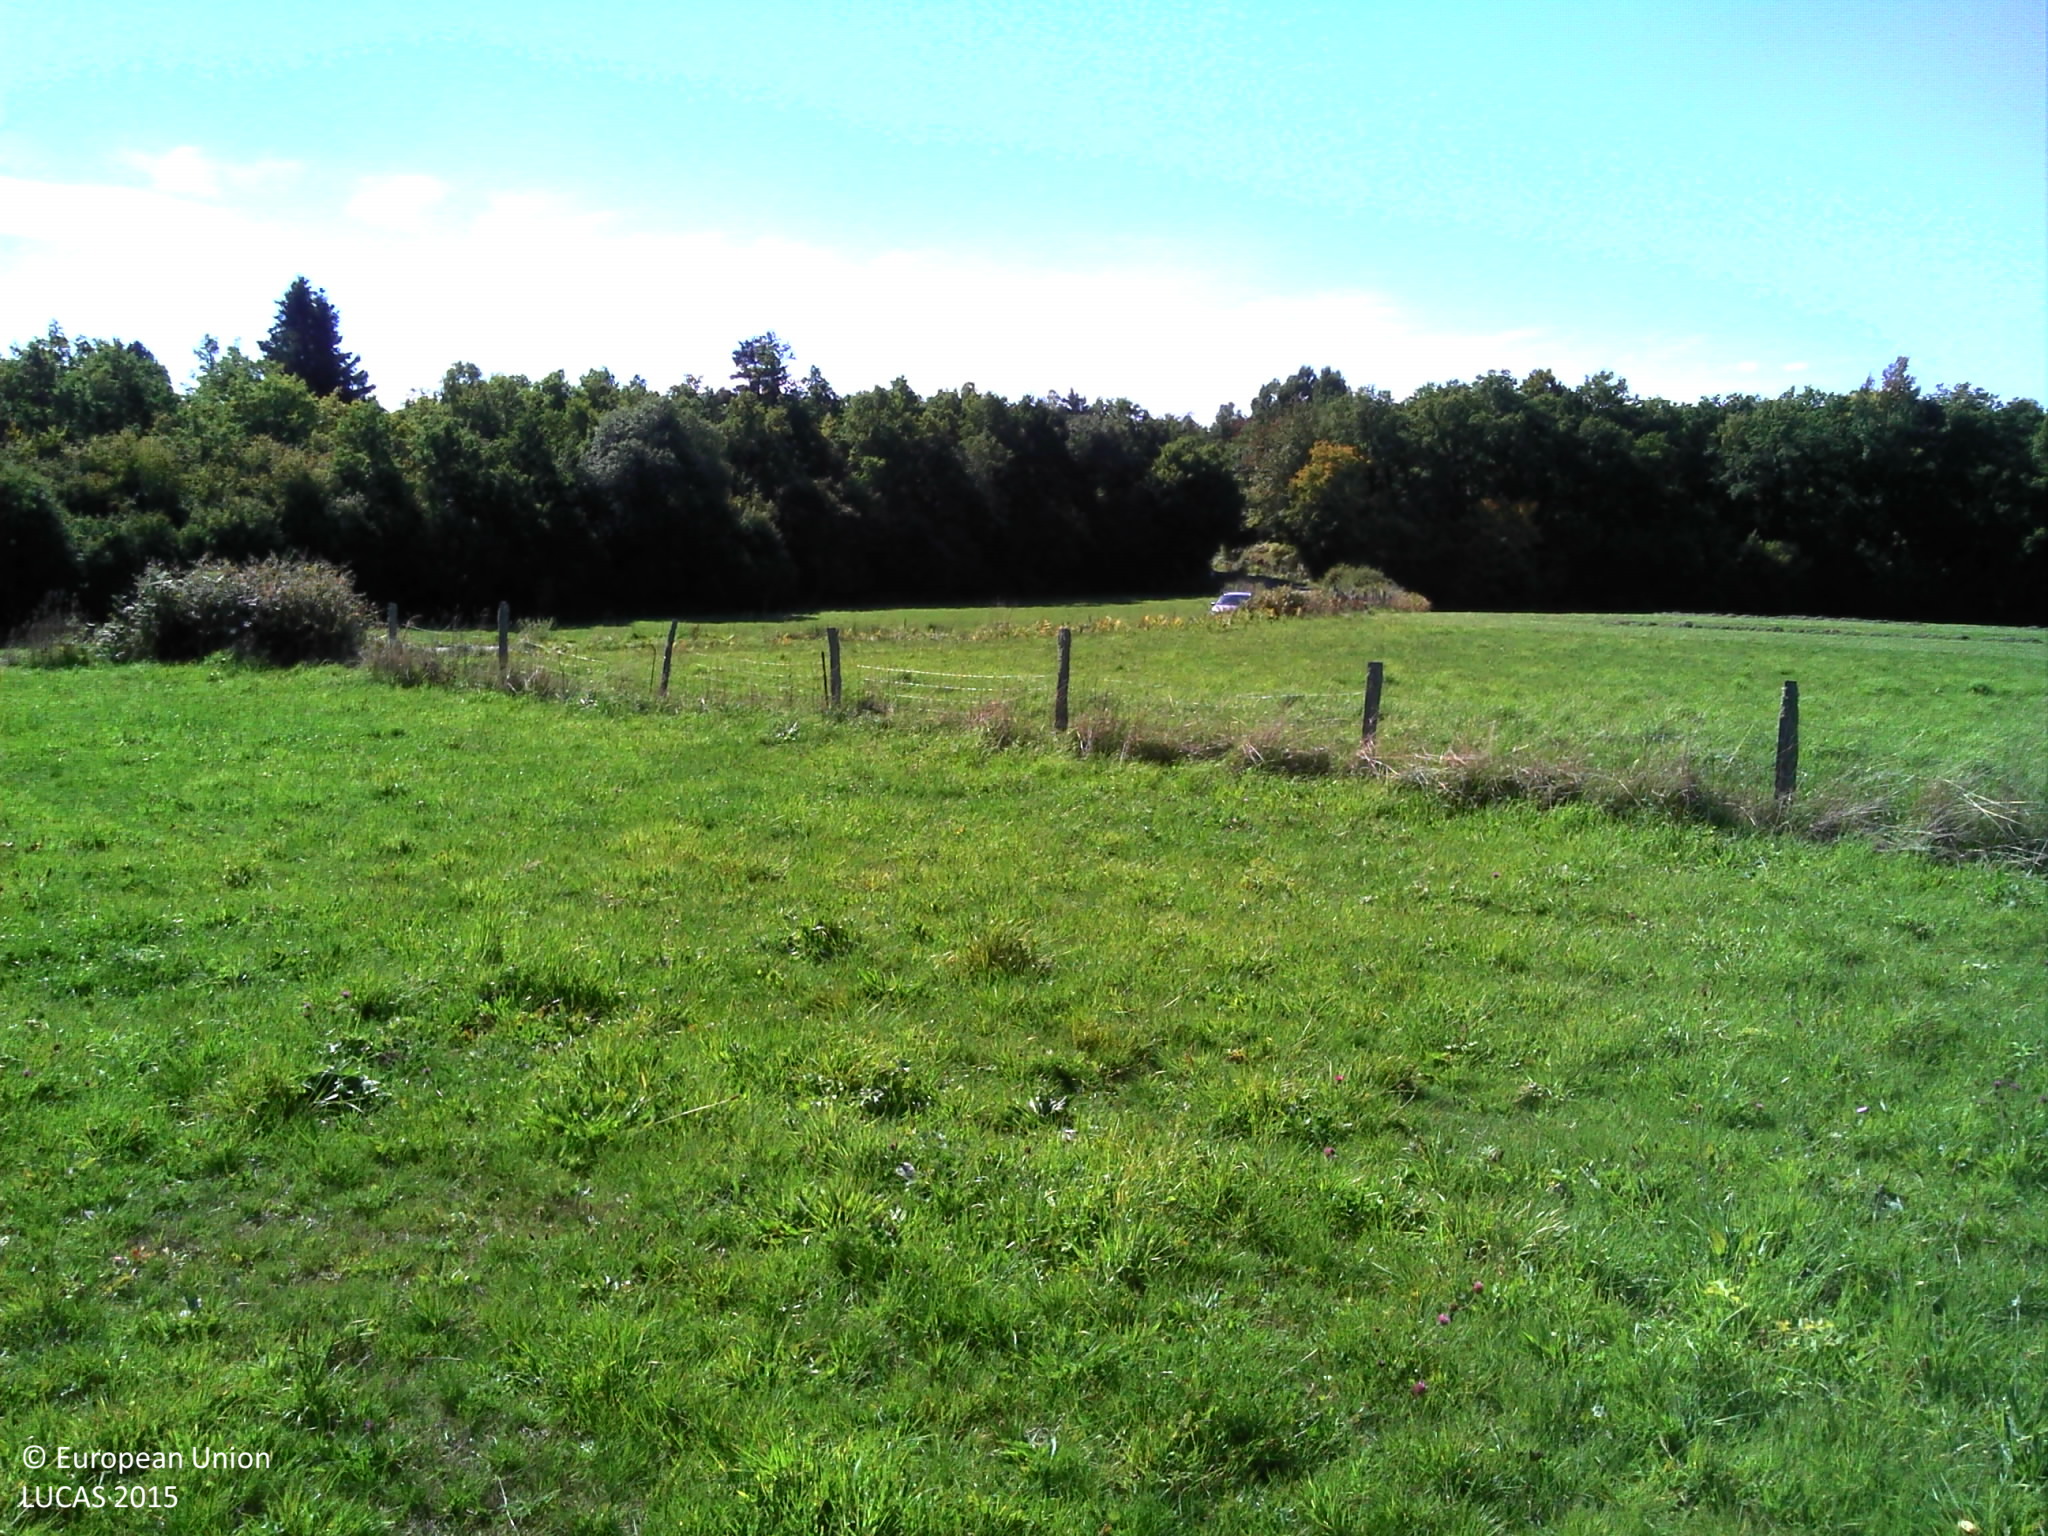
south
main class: Grassland
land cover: Grassland without tree/shrub cover
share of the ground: > 75 %
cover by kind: herbaceous plants 100 %
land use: Agriculture (excluding fallow land and kitchen gardens)
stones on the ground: < 10 %
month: September
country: FR
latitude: 45.8246
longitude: 2.8807
